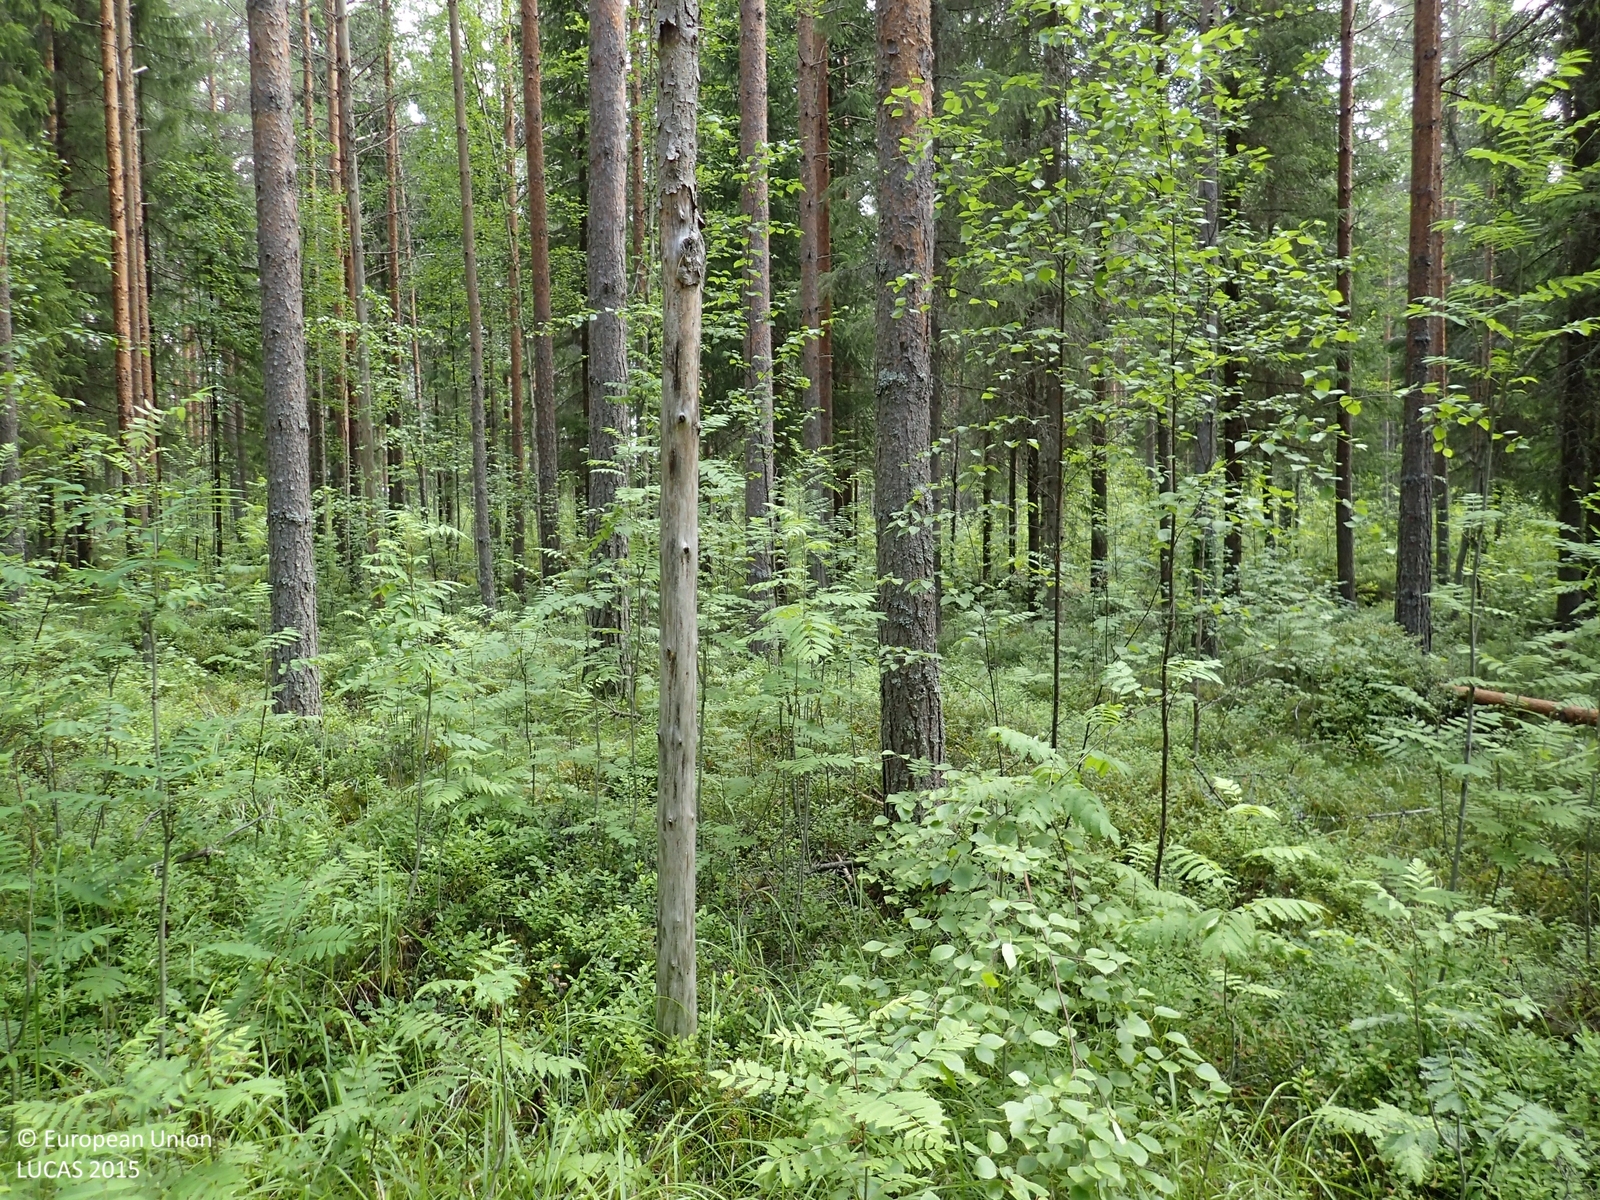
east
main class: Woodland
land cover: Pine dominated coniferous woodland
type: boreal forest
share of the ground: 50 - 75 %
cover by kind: coniferous forest trees 55 %, shrubs 30 %, broadleaved forest trees 10 %, herbaceous plants 5 %
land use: Forestry
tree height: > 5 m
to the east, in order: Pine dominated coniferous woodland; Other coniferous woodland; Spruce dominated coniferous woodland; Pine dominated coniferous woodland; Broadleaved woodland; Tracks; Ditches and canals; Tracks; Shrubland with sparse tree cover
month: July
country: FI
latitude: 62.7654
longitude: 23.5651
